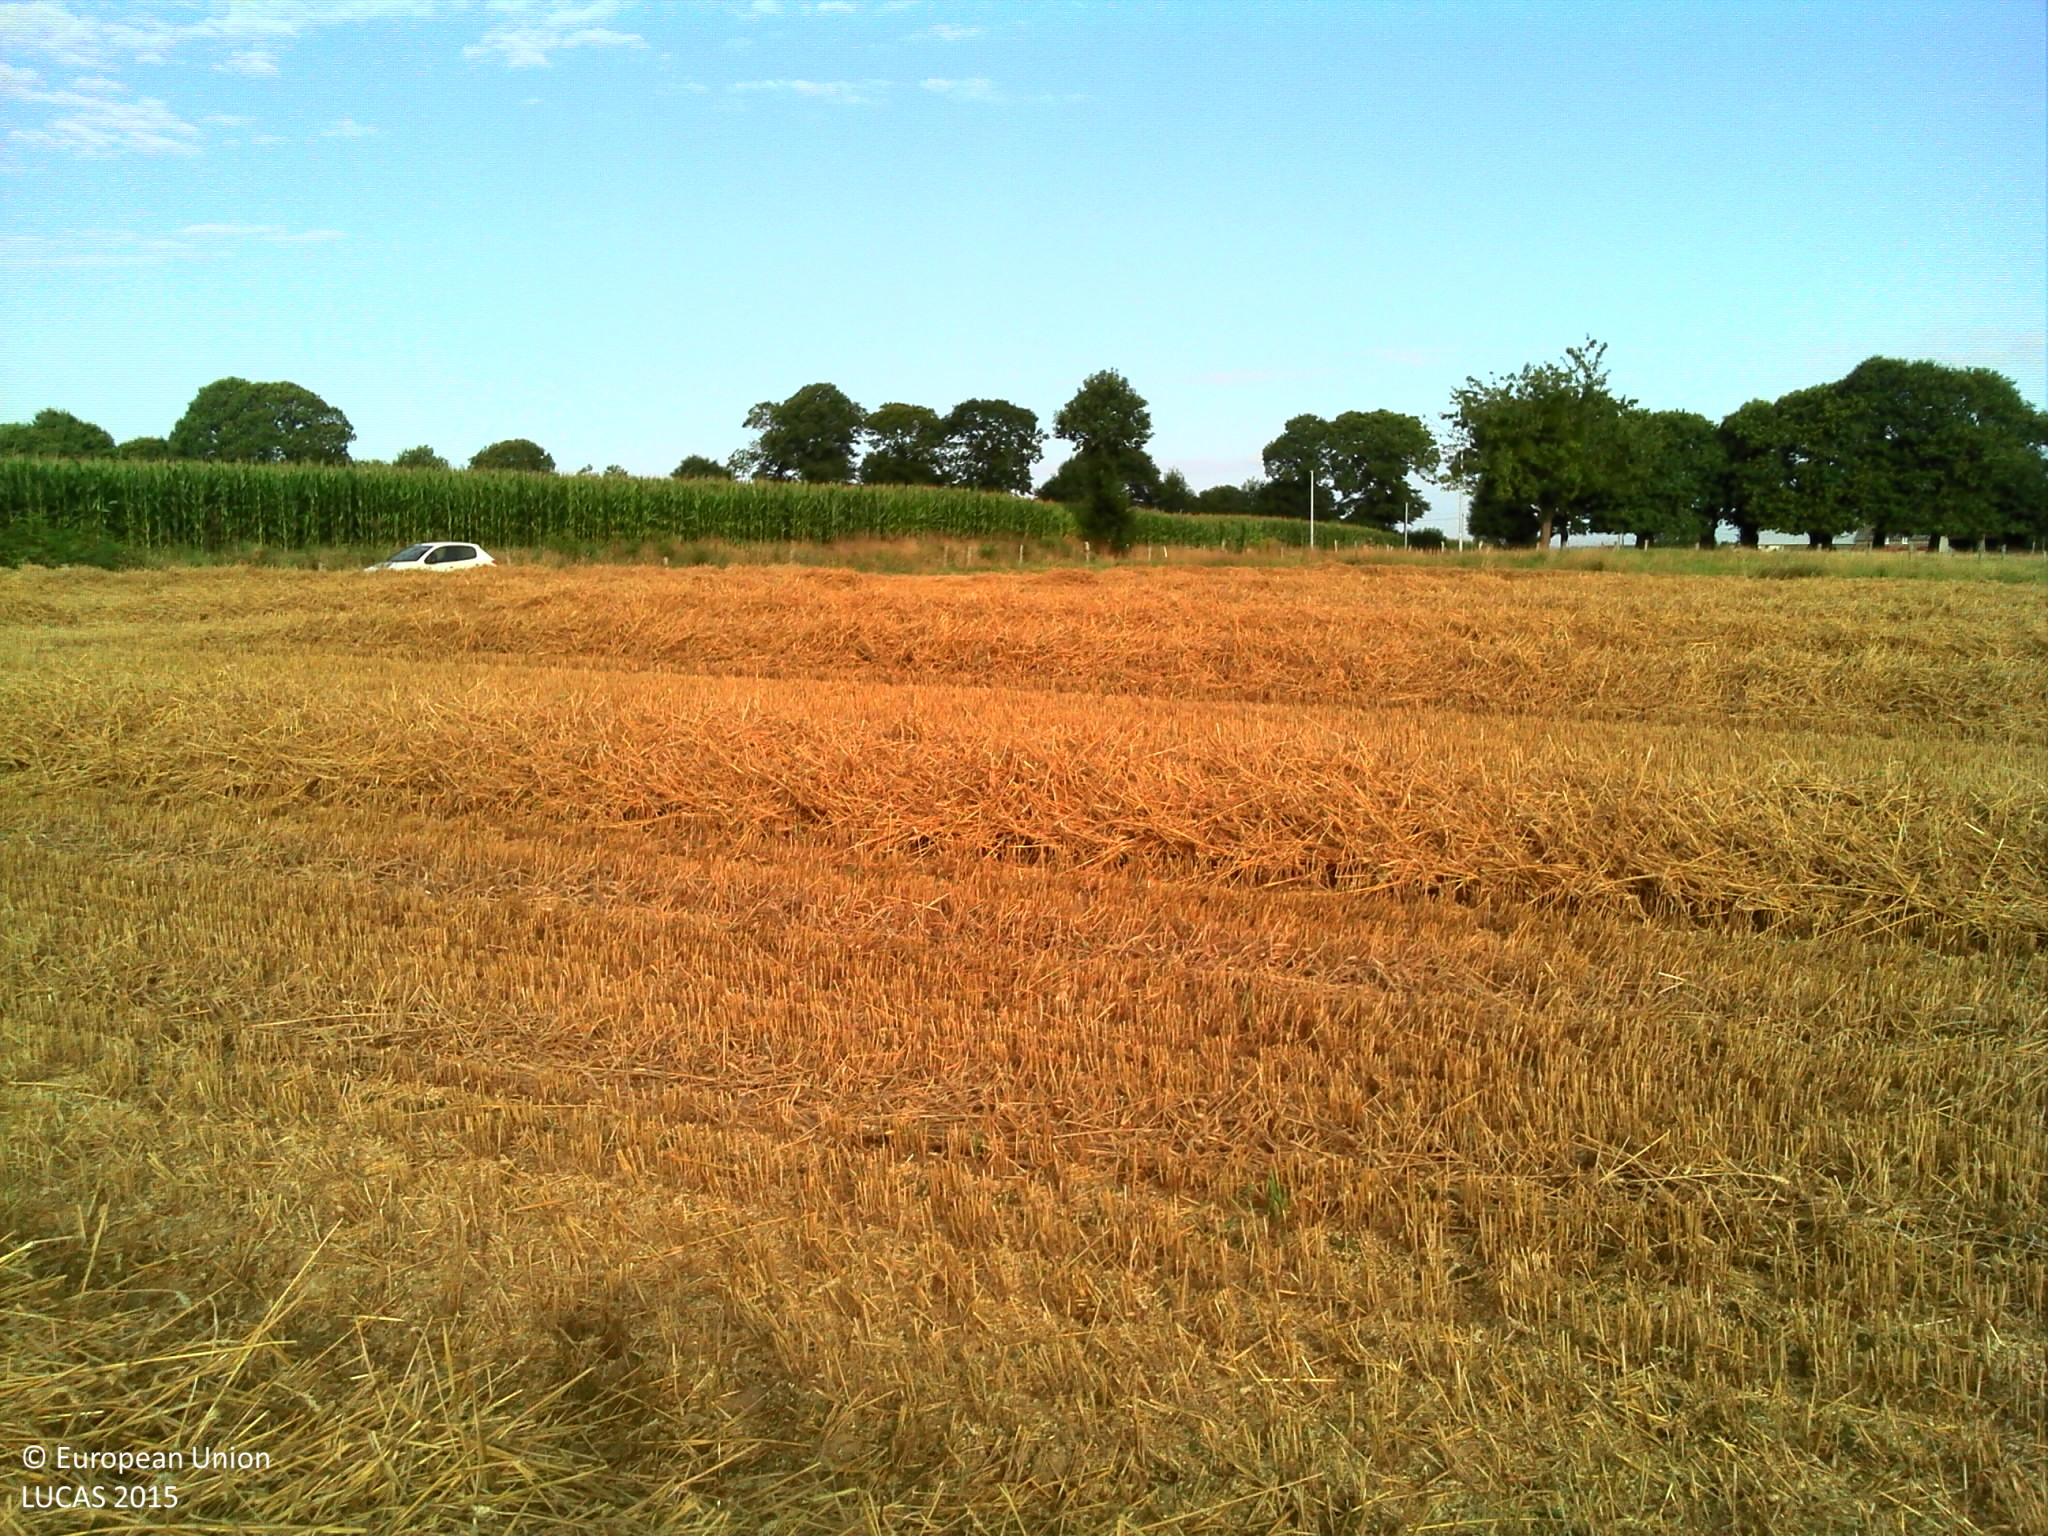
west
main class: Cropland
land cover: Common wheat
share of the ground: > 75 %
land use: Agriculture (excluding fallow land and kitchen gardens)
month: August
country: FR
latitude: 48.5309
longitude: -1.2978
